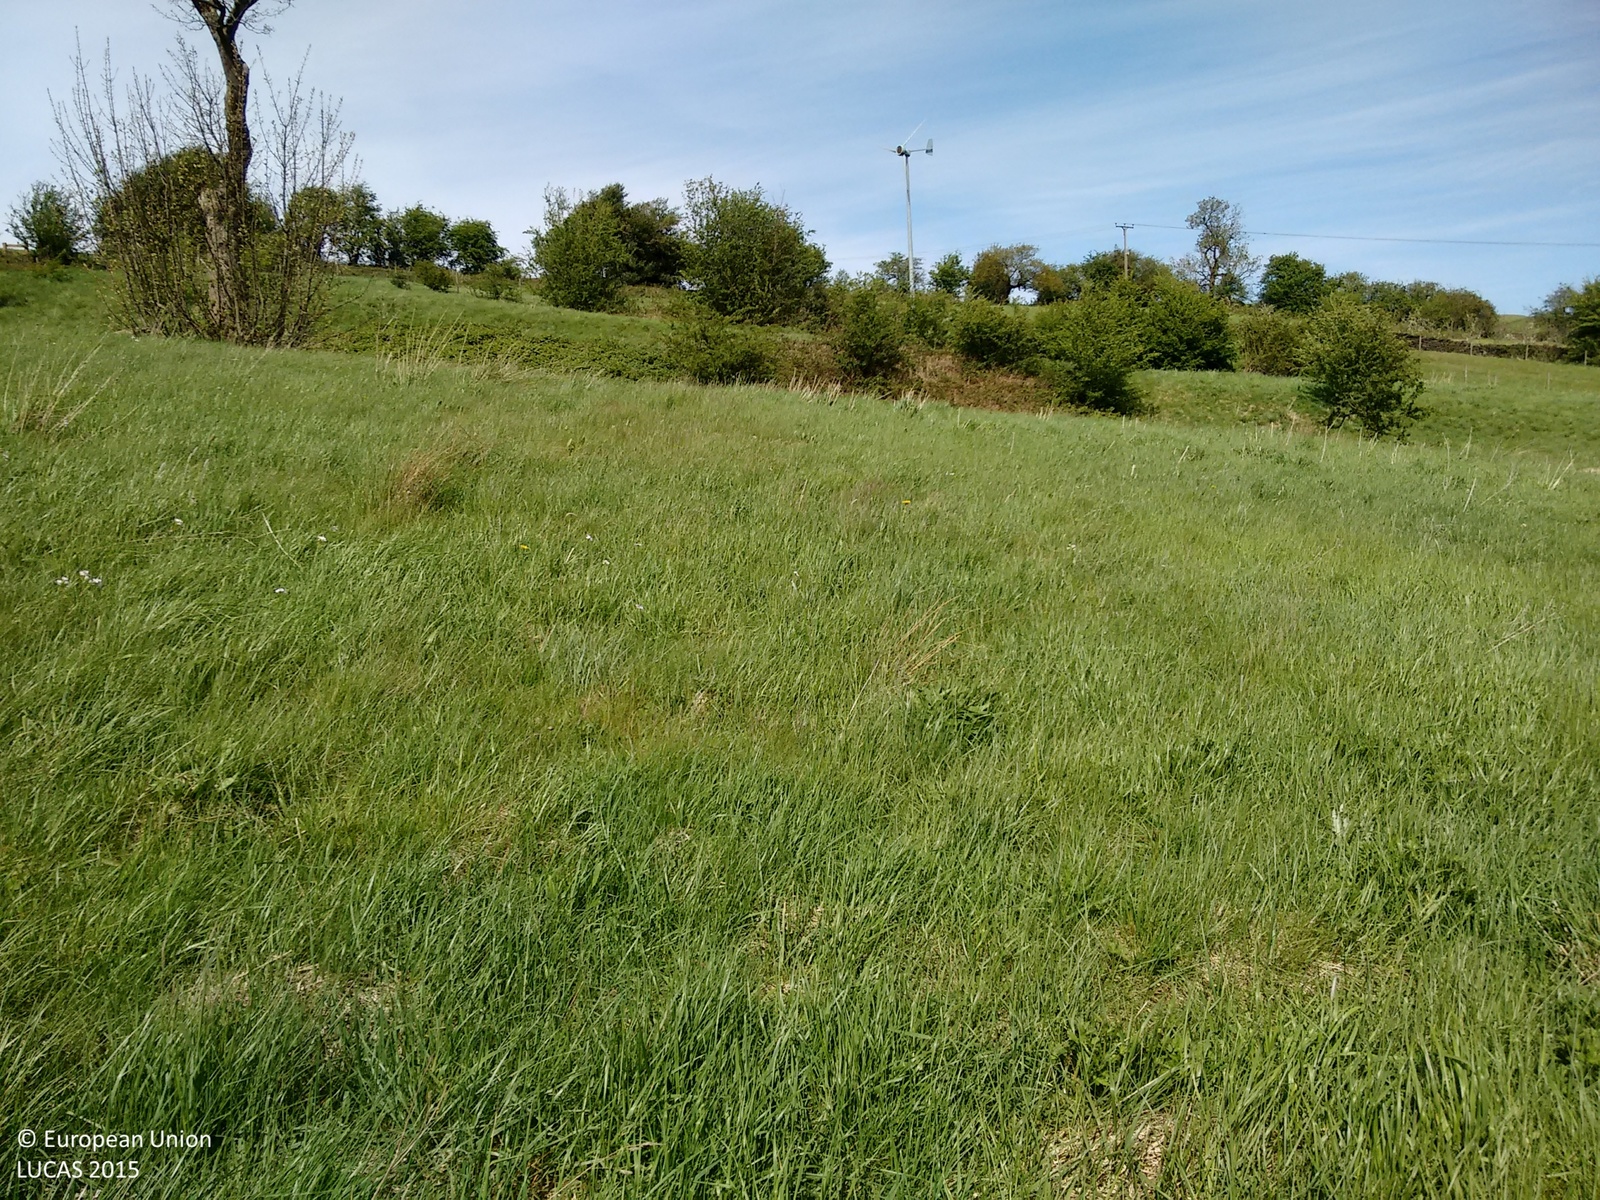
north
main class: Grassland
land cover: Grassland without tree/shrub cover
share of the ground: > 75 %
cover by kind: herbaceous plants 100 %
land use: Agriculture (excluding fallow land and kitchen gardens)
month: May
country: GB
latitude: 53.5869
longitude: -1.7919
